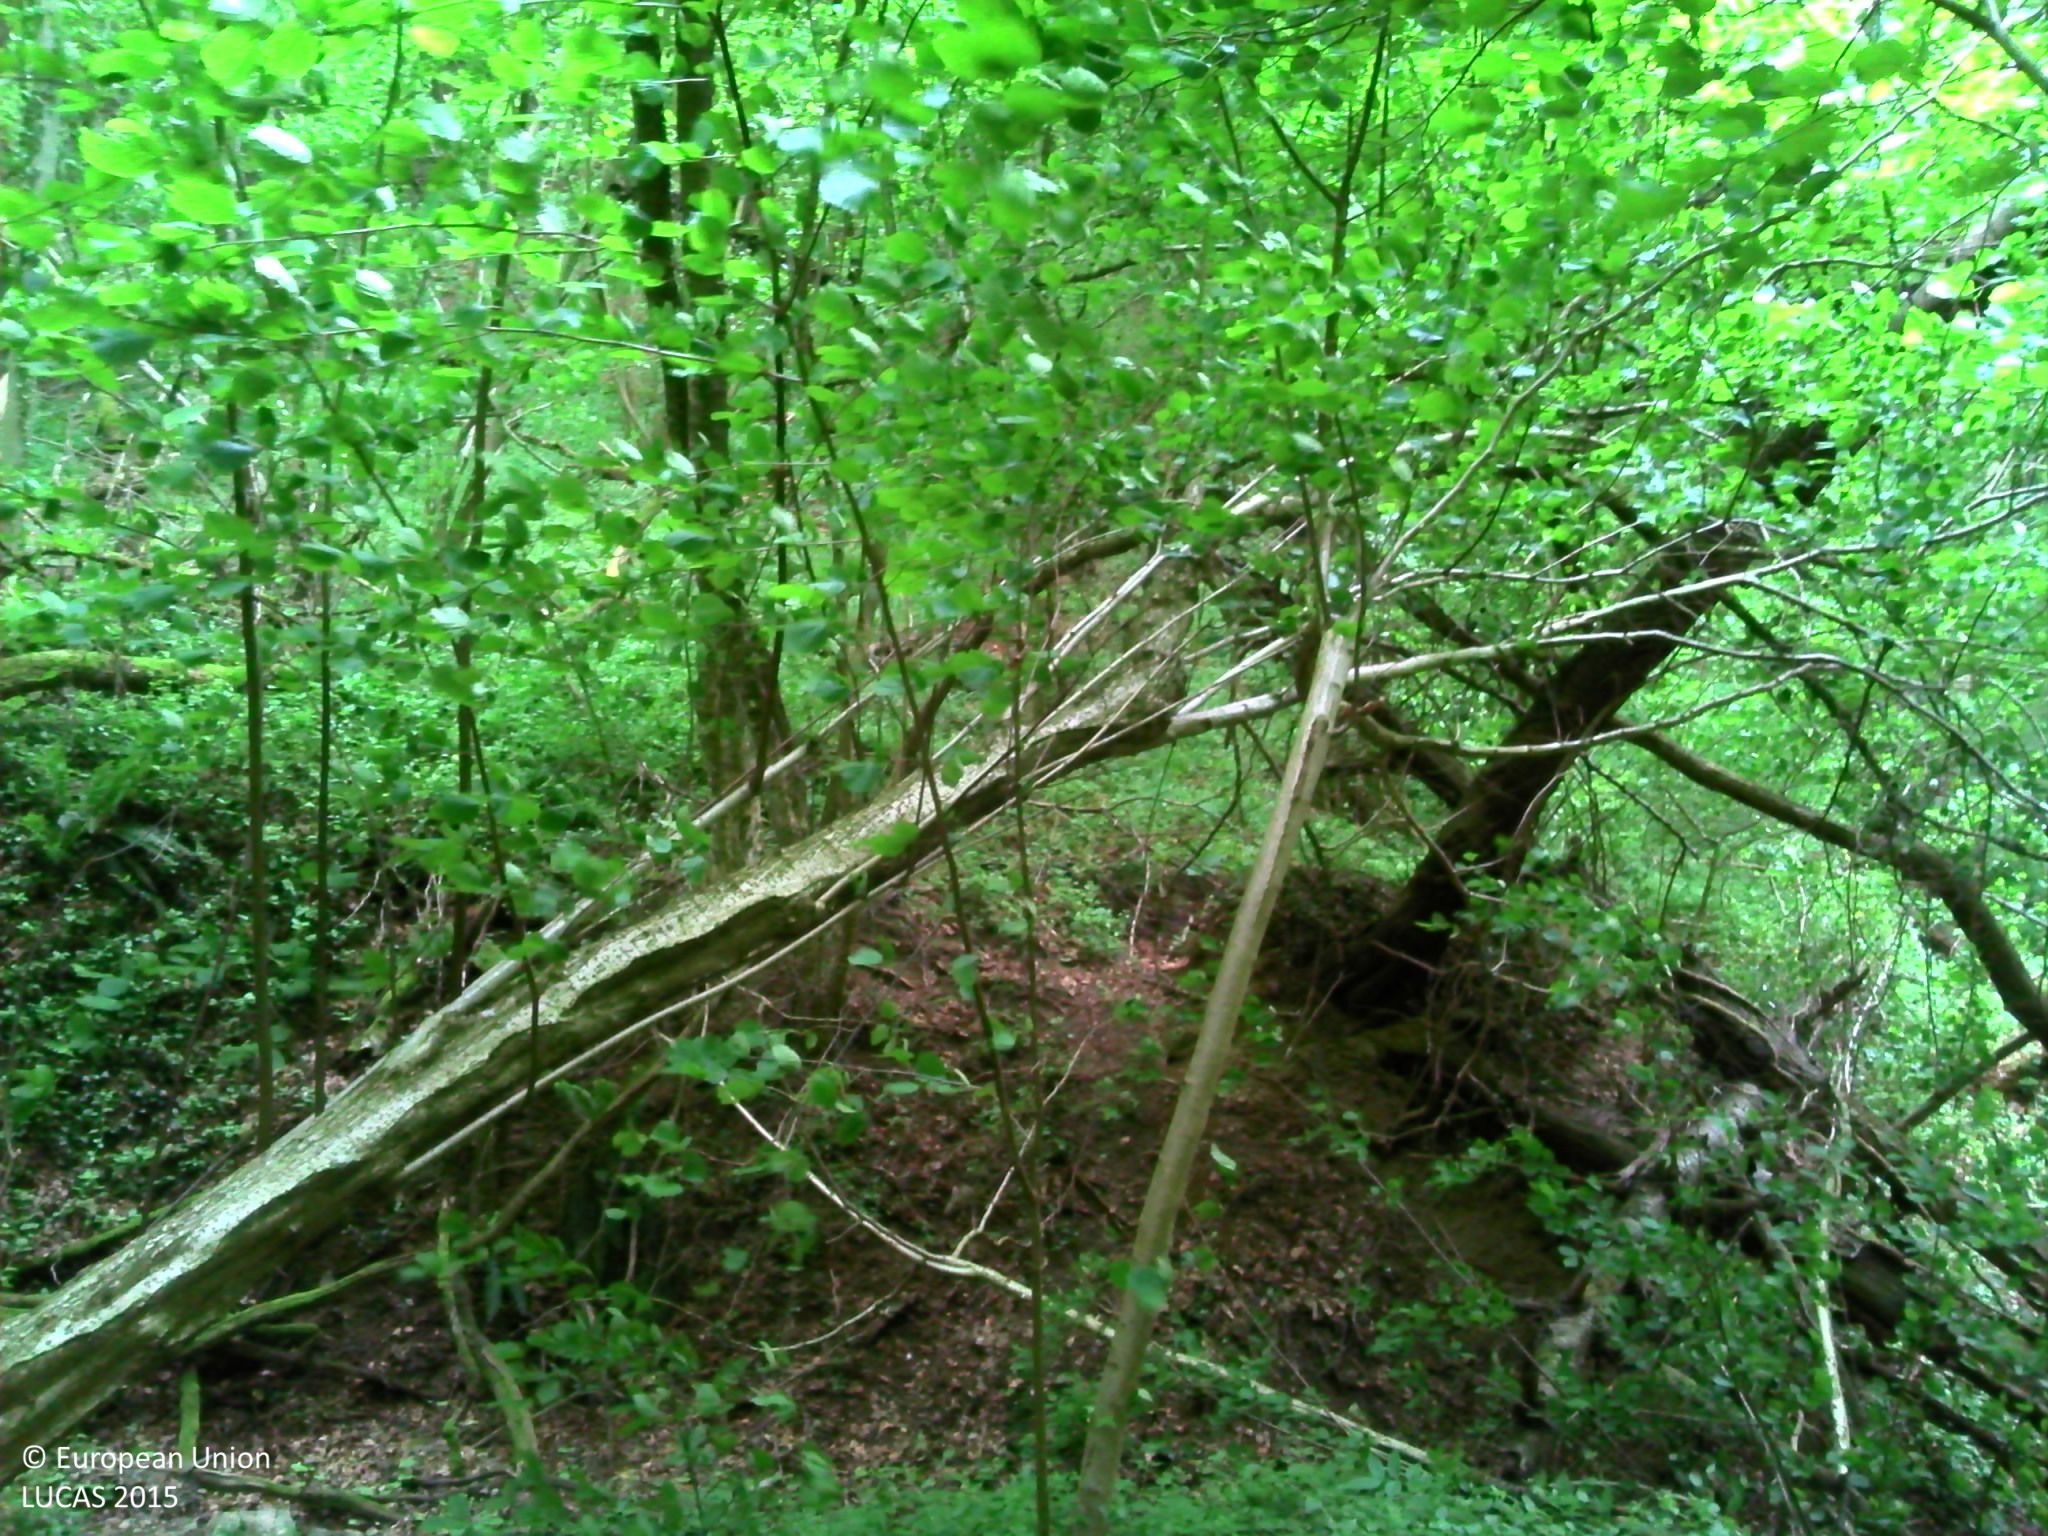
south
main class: Woodland
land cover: Broadleaved woodland
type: acidophilous oak and oak-birch forest
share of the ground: > 75 %
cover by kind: broadleaved forest trees 90 %, herbaceous plants 10 %
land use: Forestry
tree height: > 5 m
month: June
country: BE
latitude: 50.4031
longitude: 5.5383
